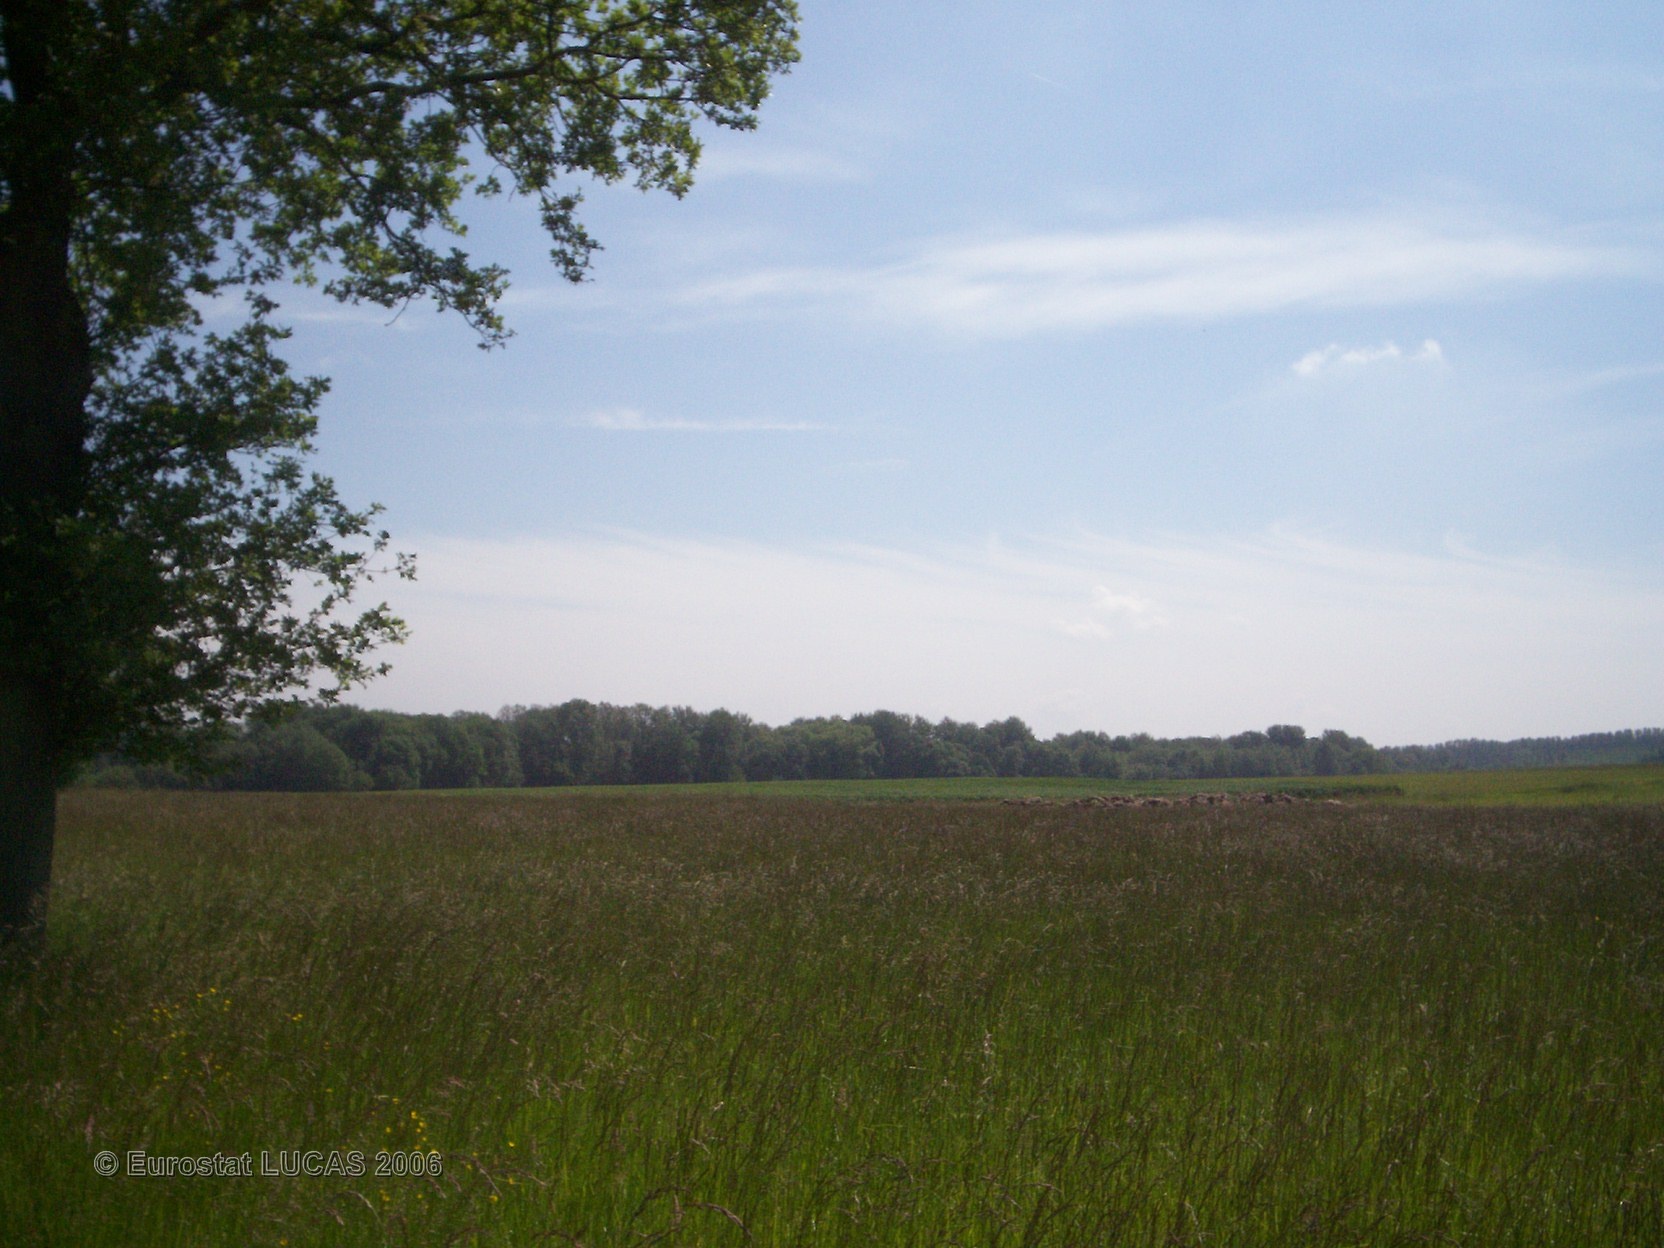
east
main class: Grassland
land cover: Grassland without tree/shrub cover
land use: Agriculture (excluding fallow land and kitchen gardens)
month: June
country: FR
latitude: 49.6247
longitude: 2.6935
